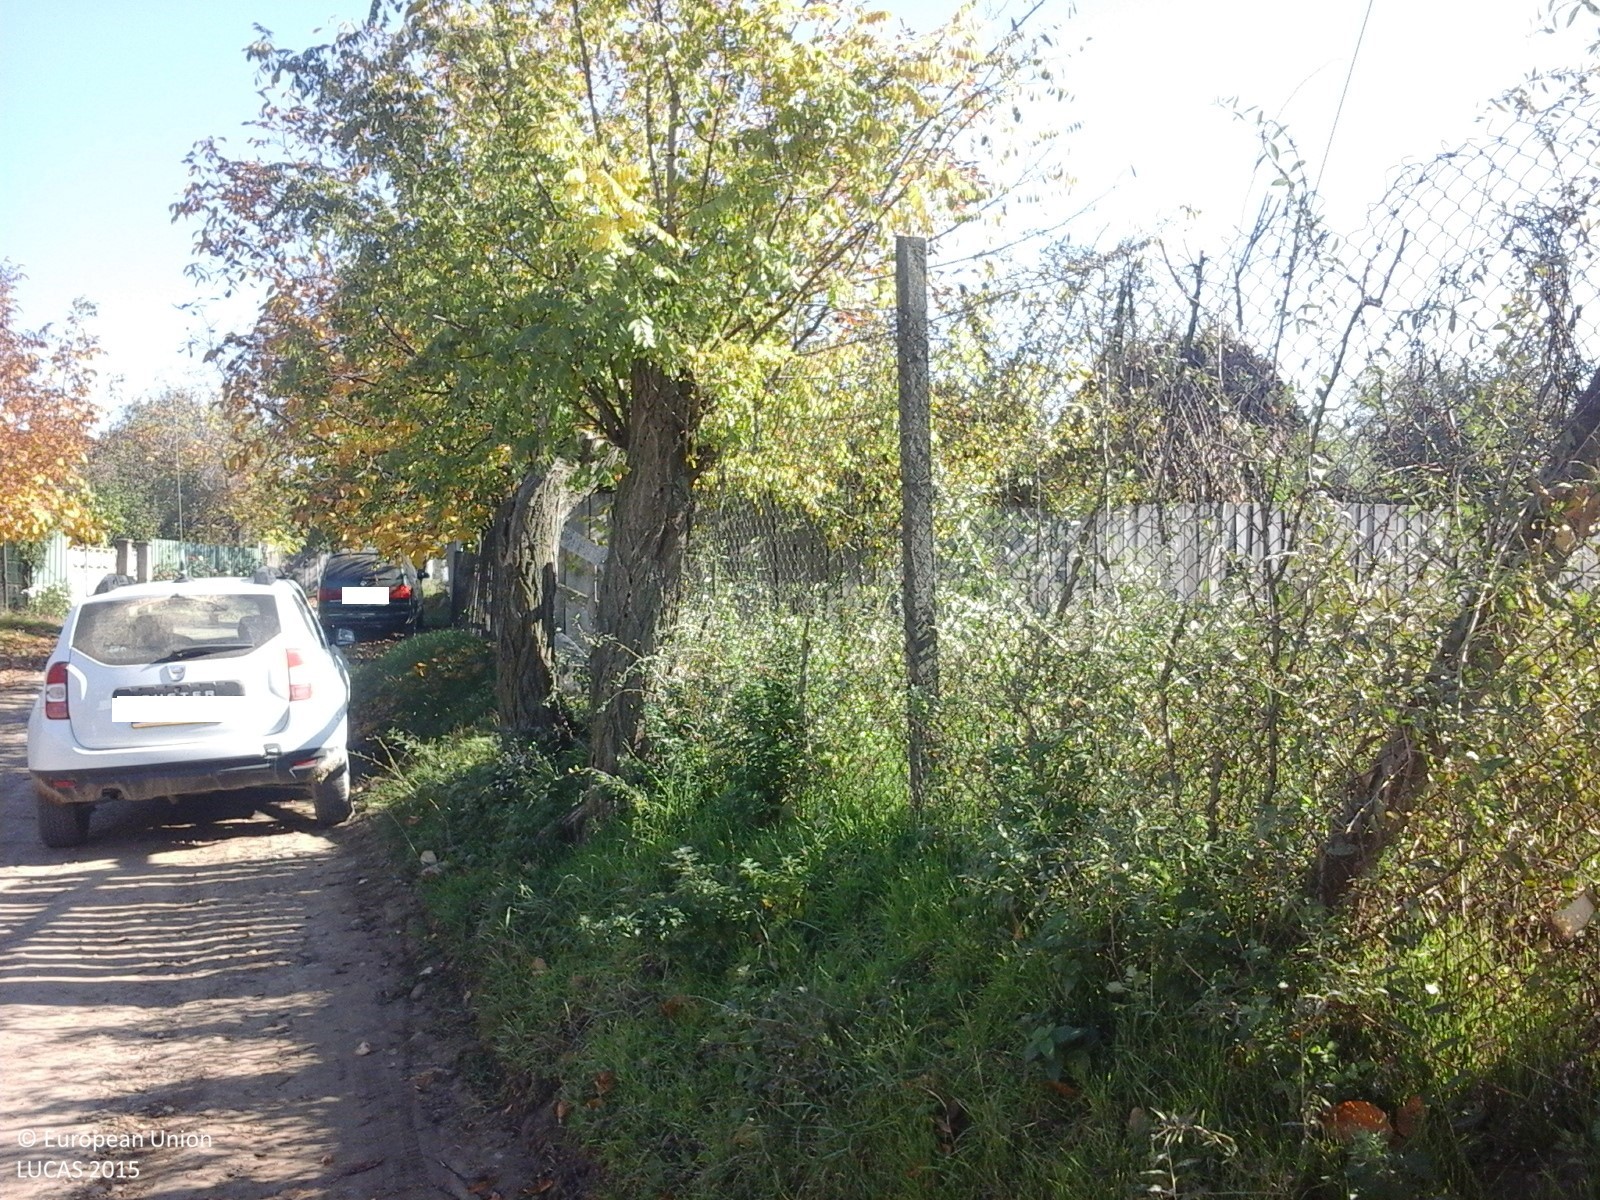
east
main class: Grassland
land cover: Spontaneously vegetated surfaces
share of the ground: > 75 %
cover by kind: herbaceous plants 100 %
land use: Fallow land
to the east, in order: Spontaneously vegetated surfaces; Maize; Vineyards; Artificial constructions in urban areas; Permanent crops (only in case pi); Vineyards; Fences; Lucerne; Lines of trees; Fences; Maize; Grassland without tree/shrub cover; Spontaneously vegetated surfaces; Other leguminous and mixtures for fodder
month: October
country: RO
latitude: 45.9524
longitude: 27.1118
